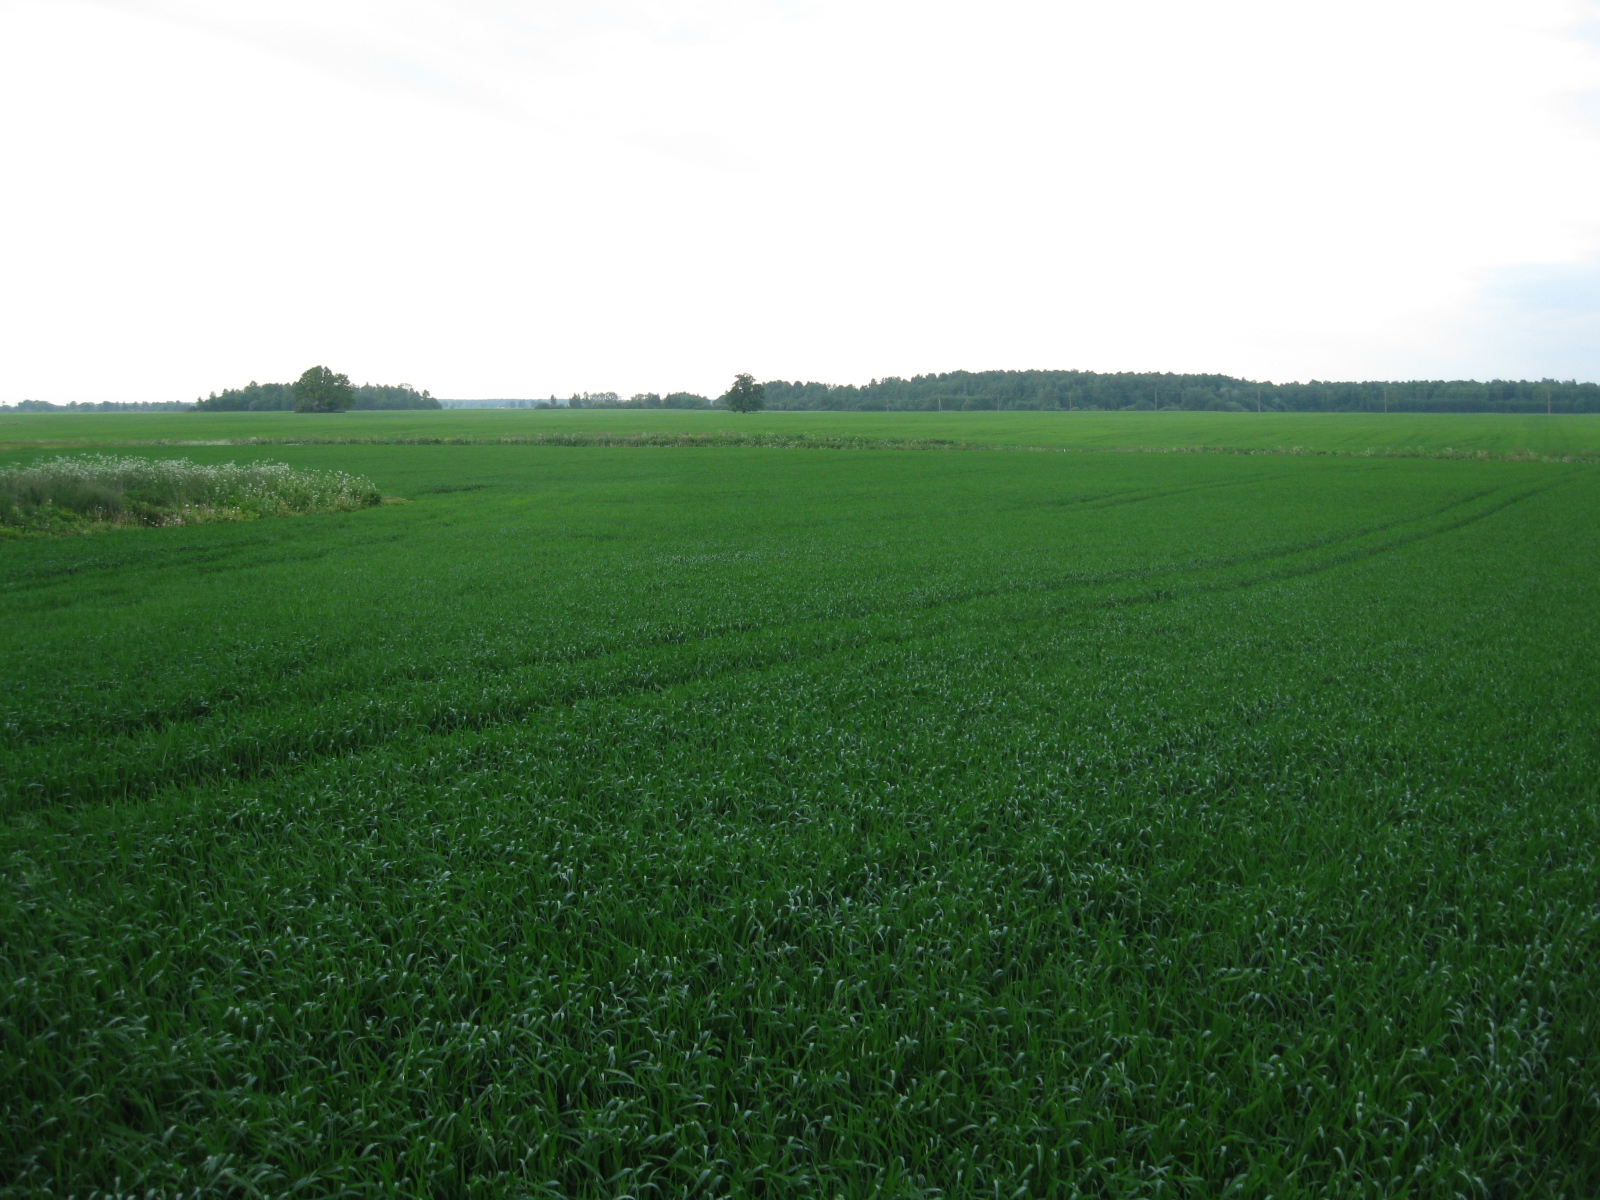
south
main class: Cropland
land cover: Common wheat
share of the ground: > 75 %
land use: Agriculture (excluding fallow land and kitchen gardens)
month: June
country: LT
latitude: 55.7236
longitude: 24.0197
